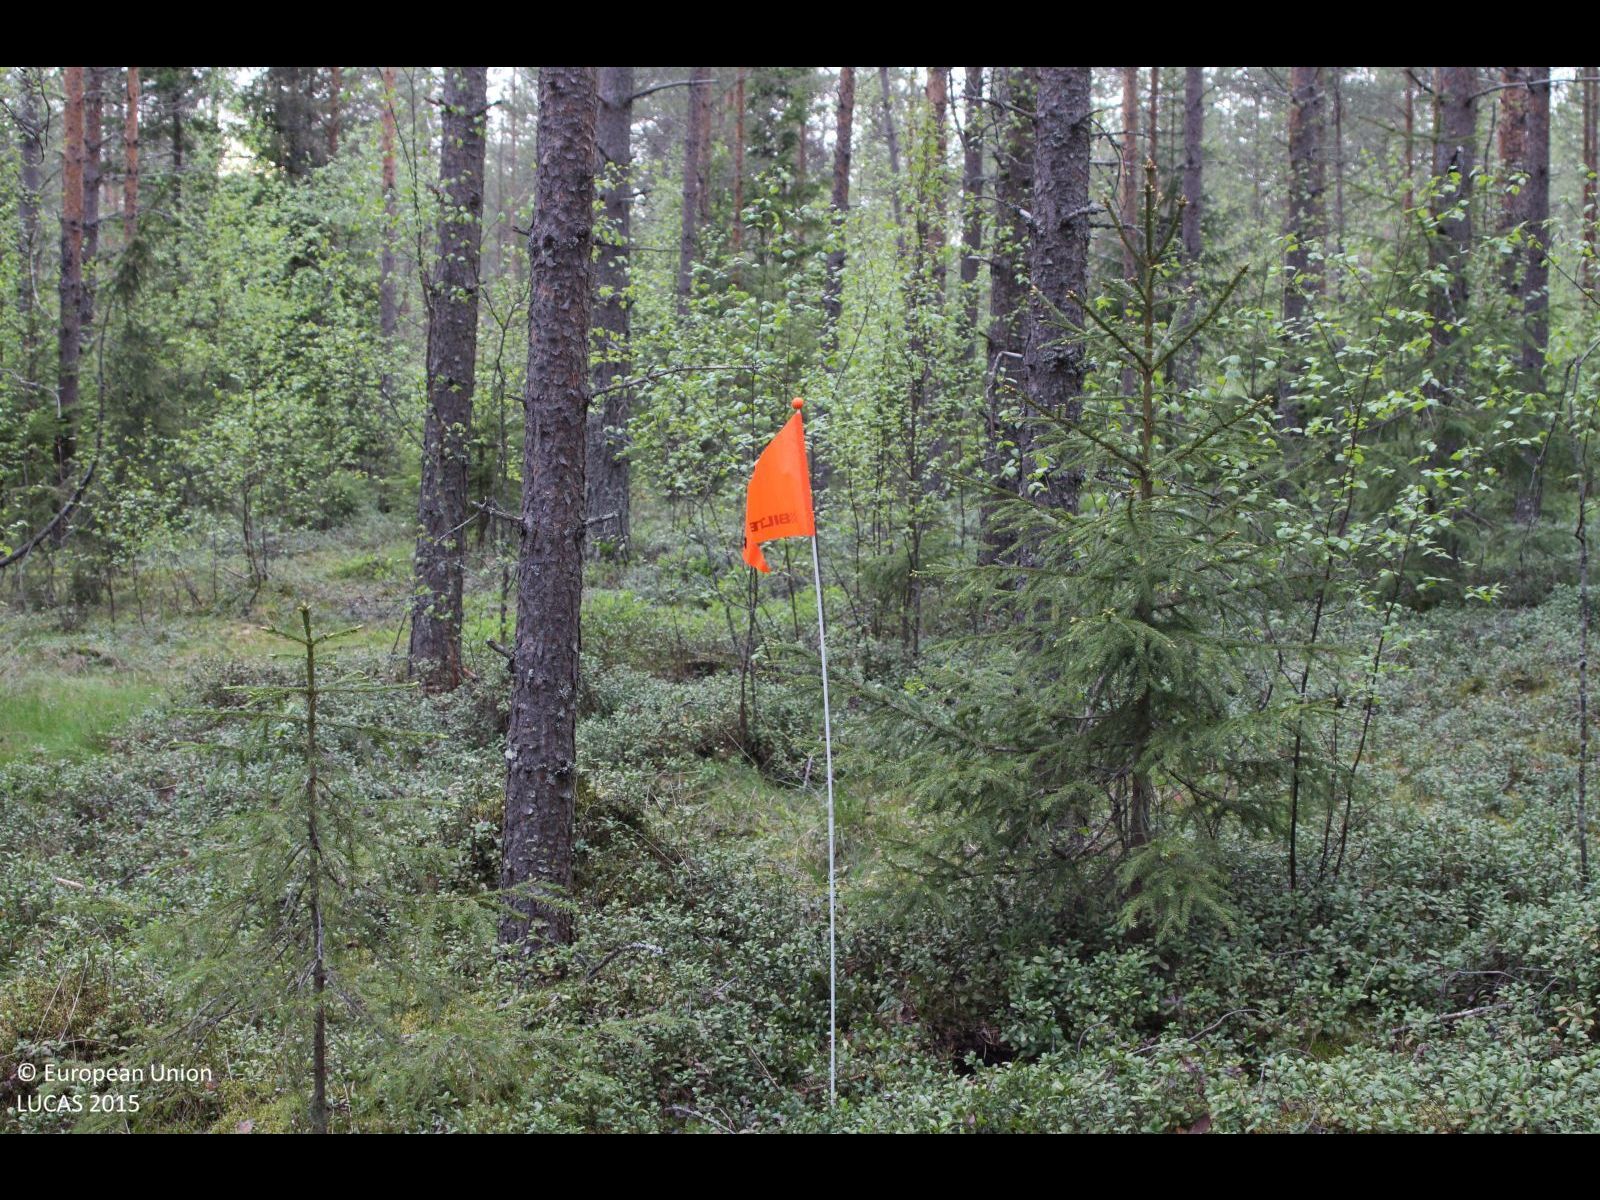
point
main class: Woodland
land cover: Pine dominated coniferous woodland
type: boreal forest
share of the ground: > 75 %
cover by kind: coniferous forest trees 70 %, shrubs 20 %, broadleaved forest trees 5 %, lichens and mosses 5 %
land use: Forestry
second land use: Community services
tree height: > 5 m
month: June
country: FI
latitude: 65.0389
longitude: 25.6539
